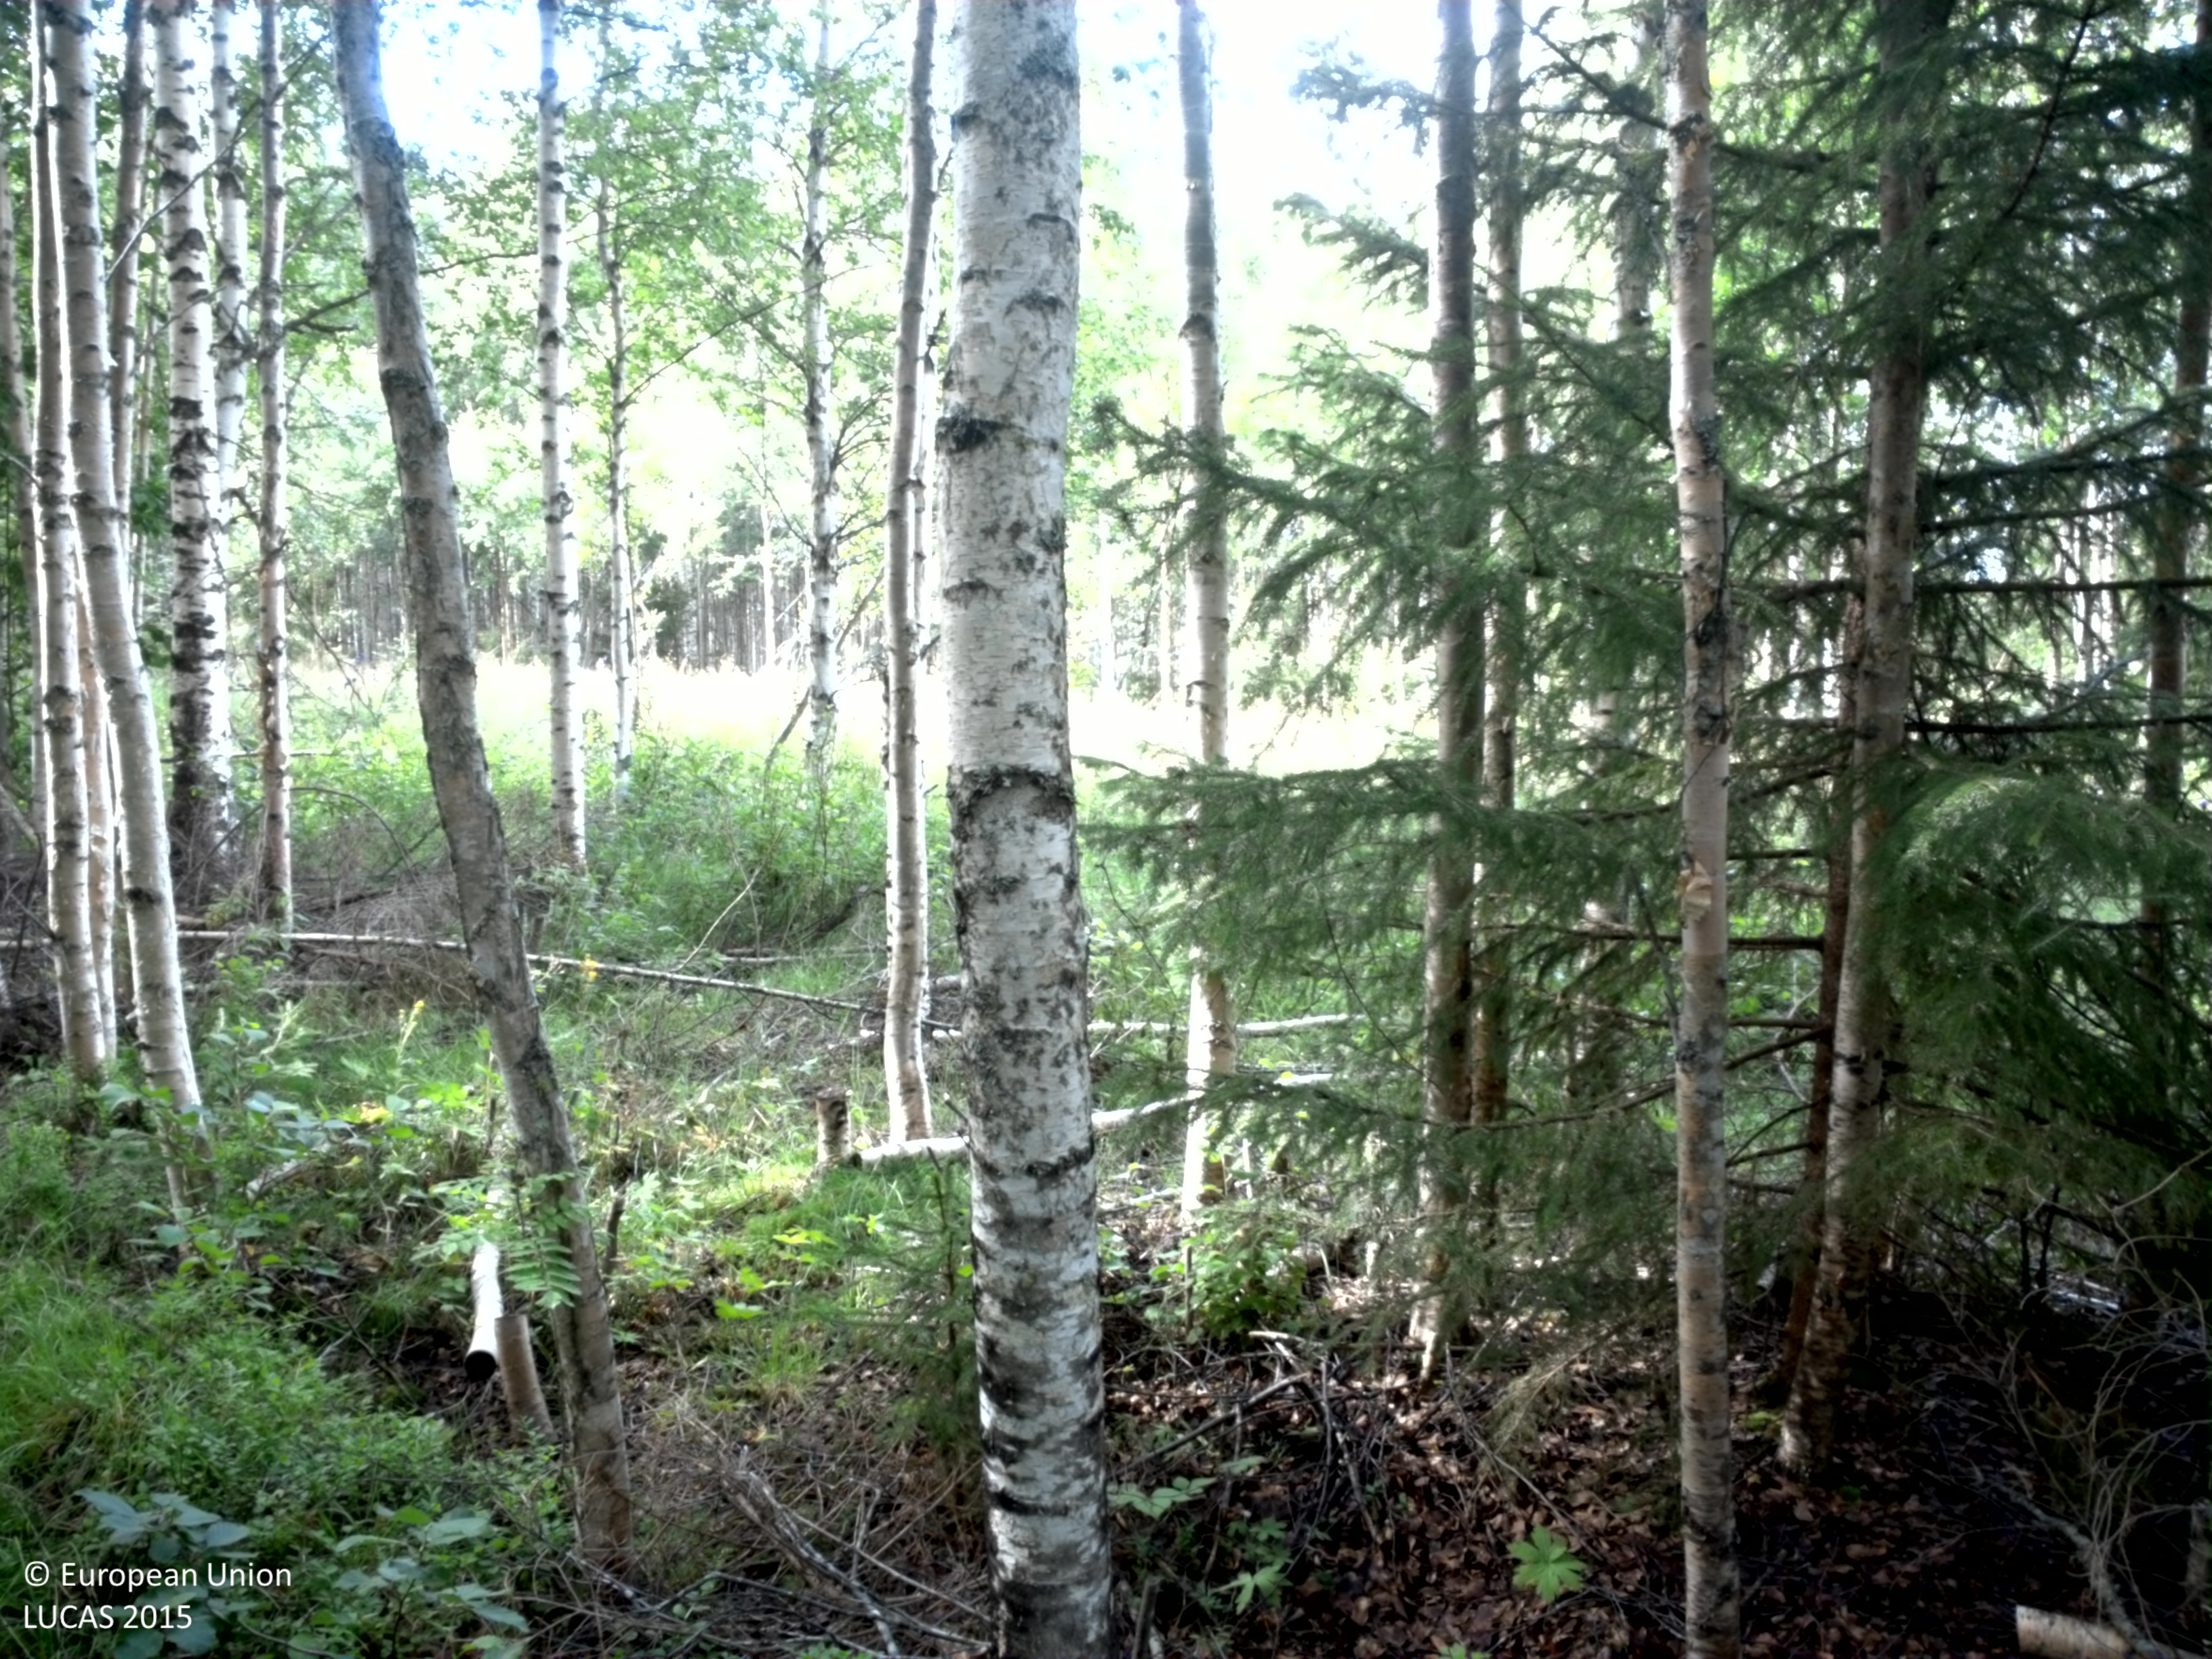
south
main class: Woodland
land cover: Other mixed woodland
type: boreal forest
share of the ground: > 75 %
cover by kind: broadleaved forest trees 45 %, coniferous forest trees 35 %, shrubs 10 %, herbaceous plants 10 %
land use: Forestry
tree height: > 5 m
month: August
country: SE
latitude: 64.6853
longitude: 20.8141
